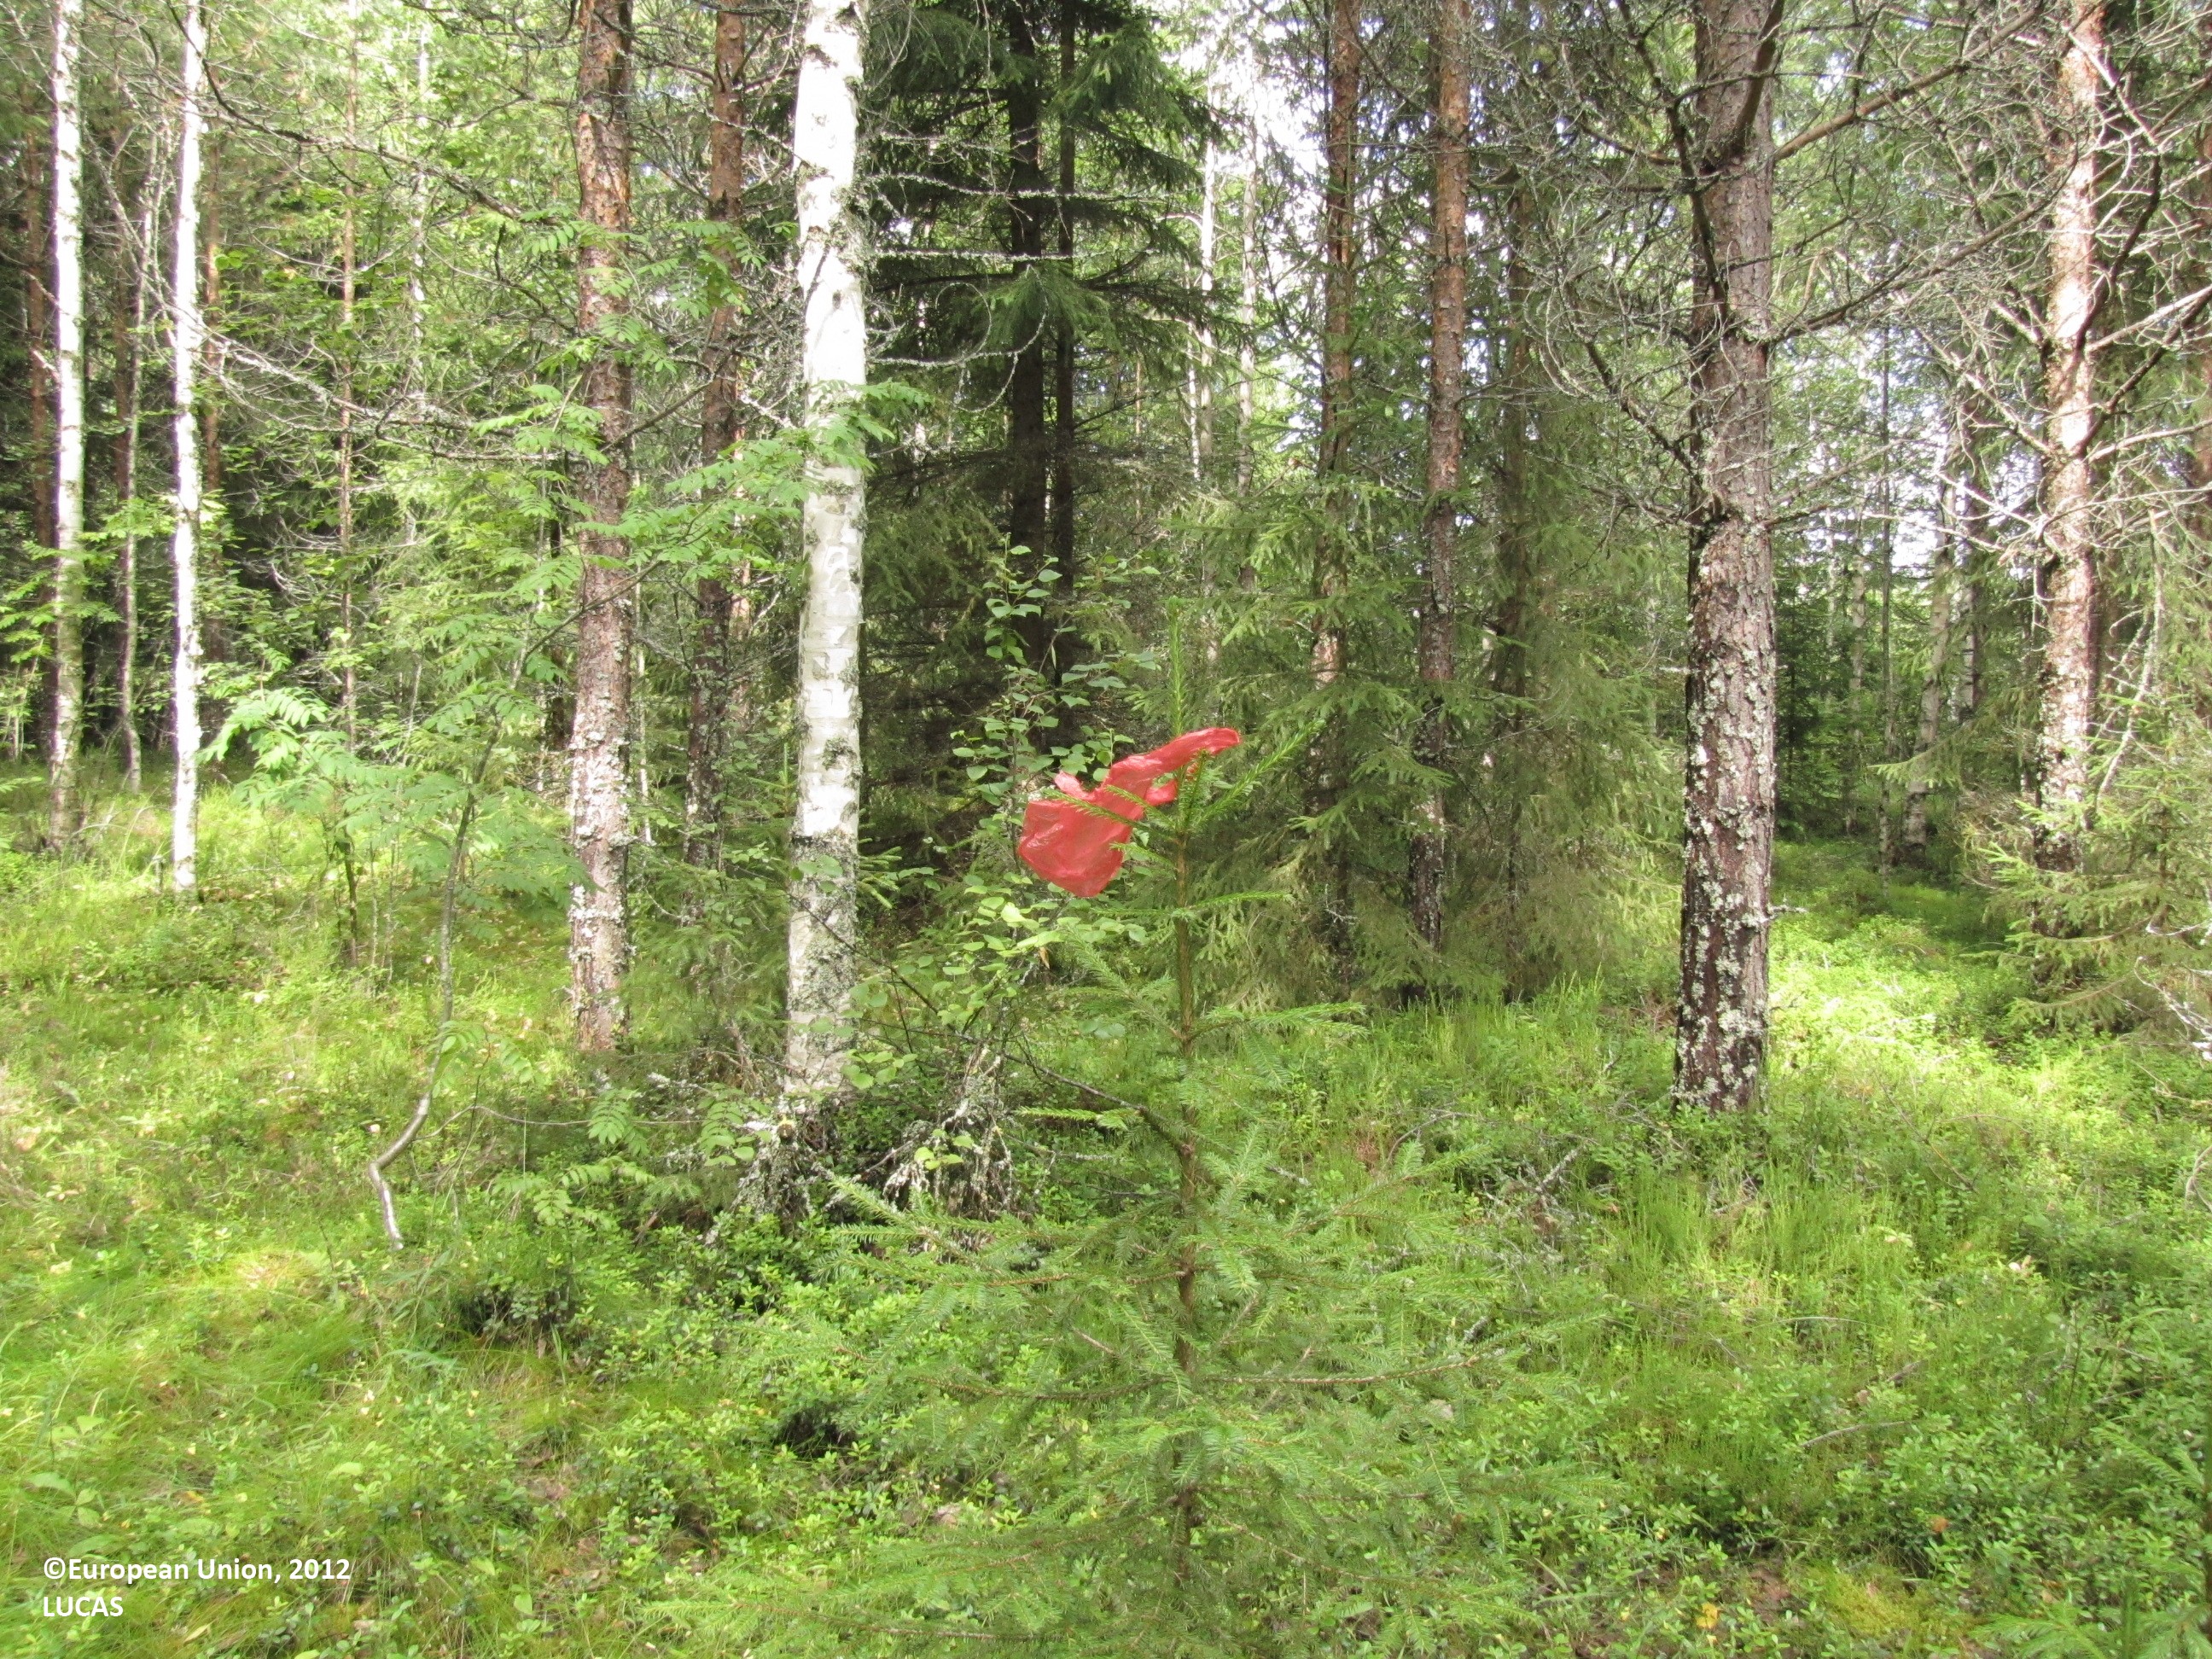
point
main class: Woodland
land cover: Other mixed woodland
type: boreal forest
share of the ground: 50 - 75 %
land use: Forestry
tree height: > 5 m
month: July
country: FI
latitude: 62.2499
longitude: 23.1782
